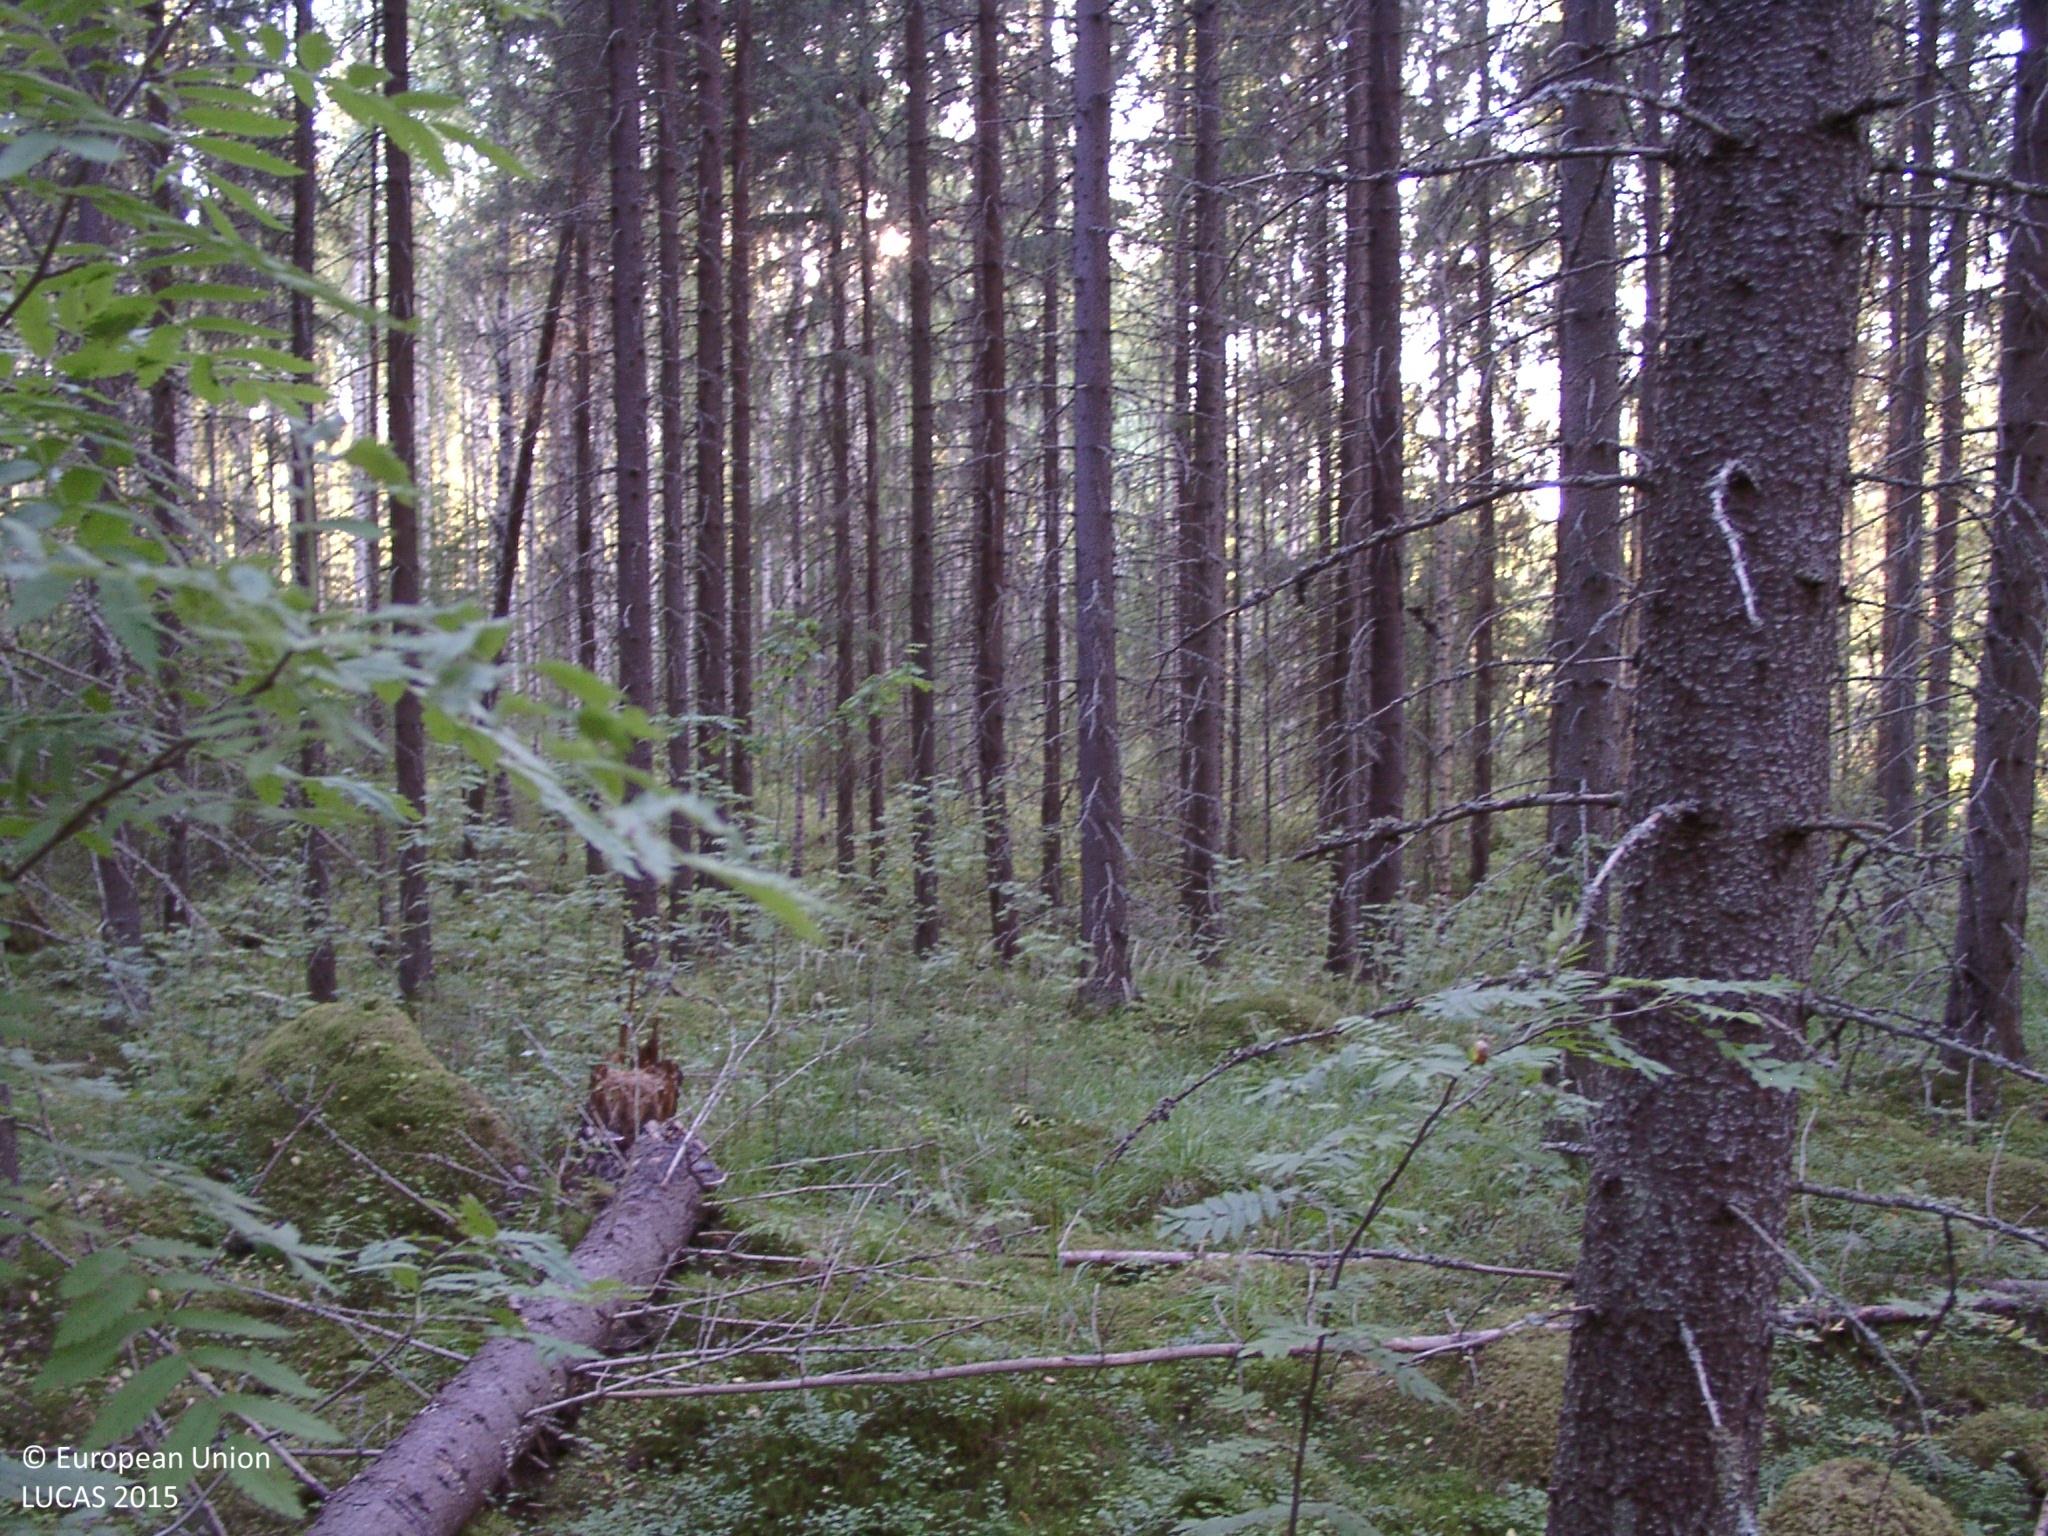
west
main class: Woodland
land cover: Spruce dominated coniferous woodland
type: boreal forest
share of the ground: > 75 %
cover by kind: coniferous forest trees 75 %, broadleaved forest trees 10 %, lichens and mosses 10 %, herbaceous plants 5 %
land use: Forestry
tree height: > 5 m
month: August
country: FI
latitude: 62.0002
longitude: 25.0177
